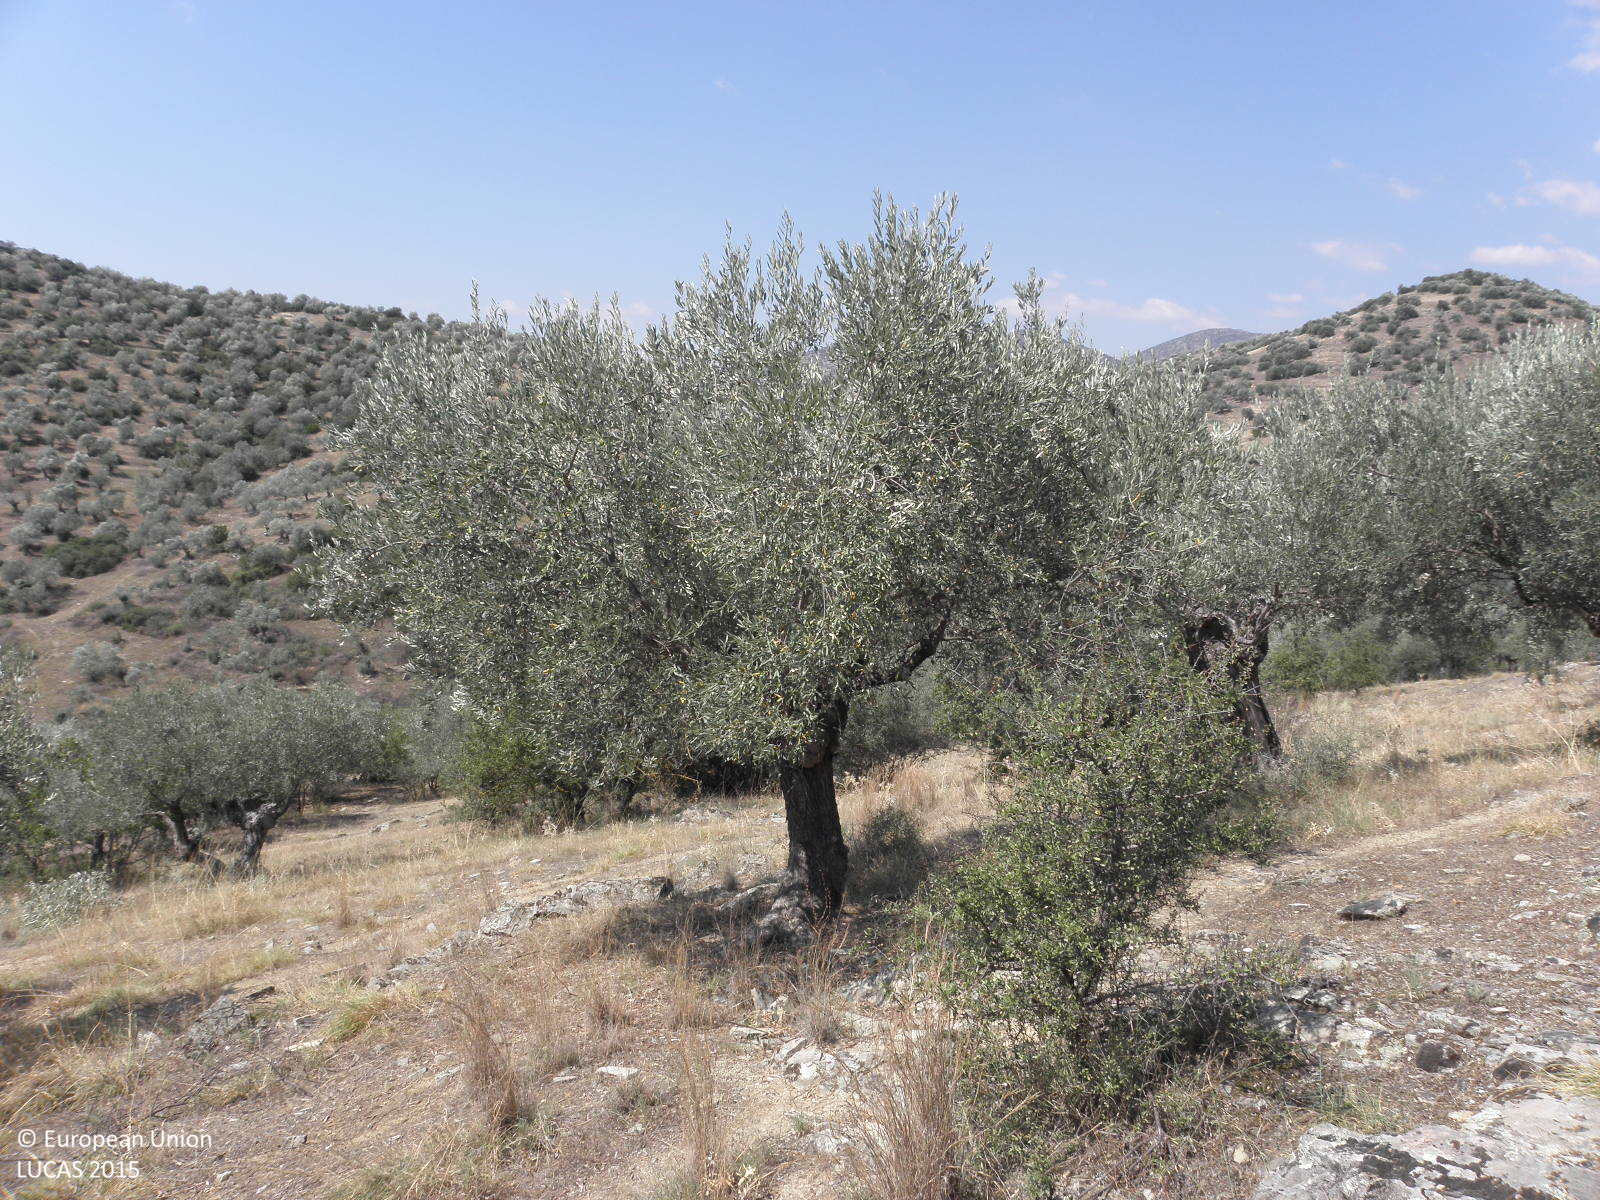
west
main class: Cropland
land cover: Olive groves
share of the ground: 25 - 50 %
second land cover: Spontaneously vegetated surfaces
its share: > 75 %
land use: Agriculture (excluding fallow land and kitchen gardens)
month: August
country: GR
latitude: 39.8382
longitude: 22.4377
